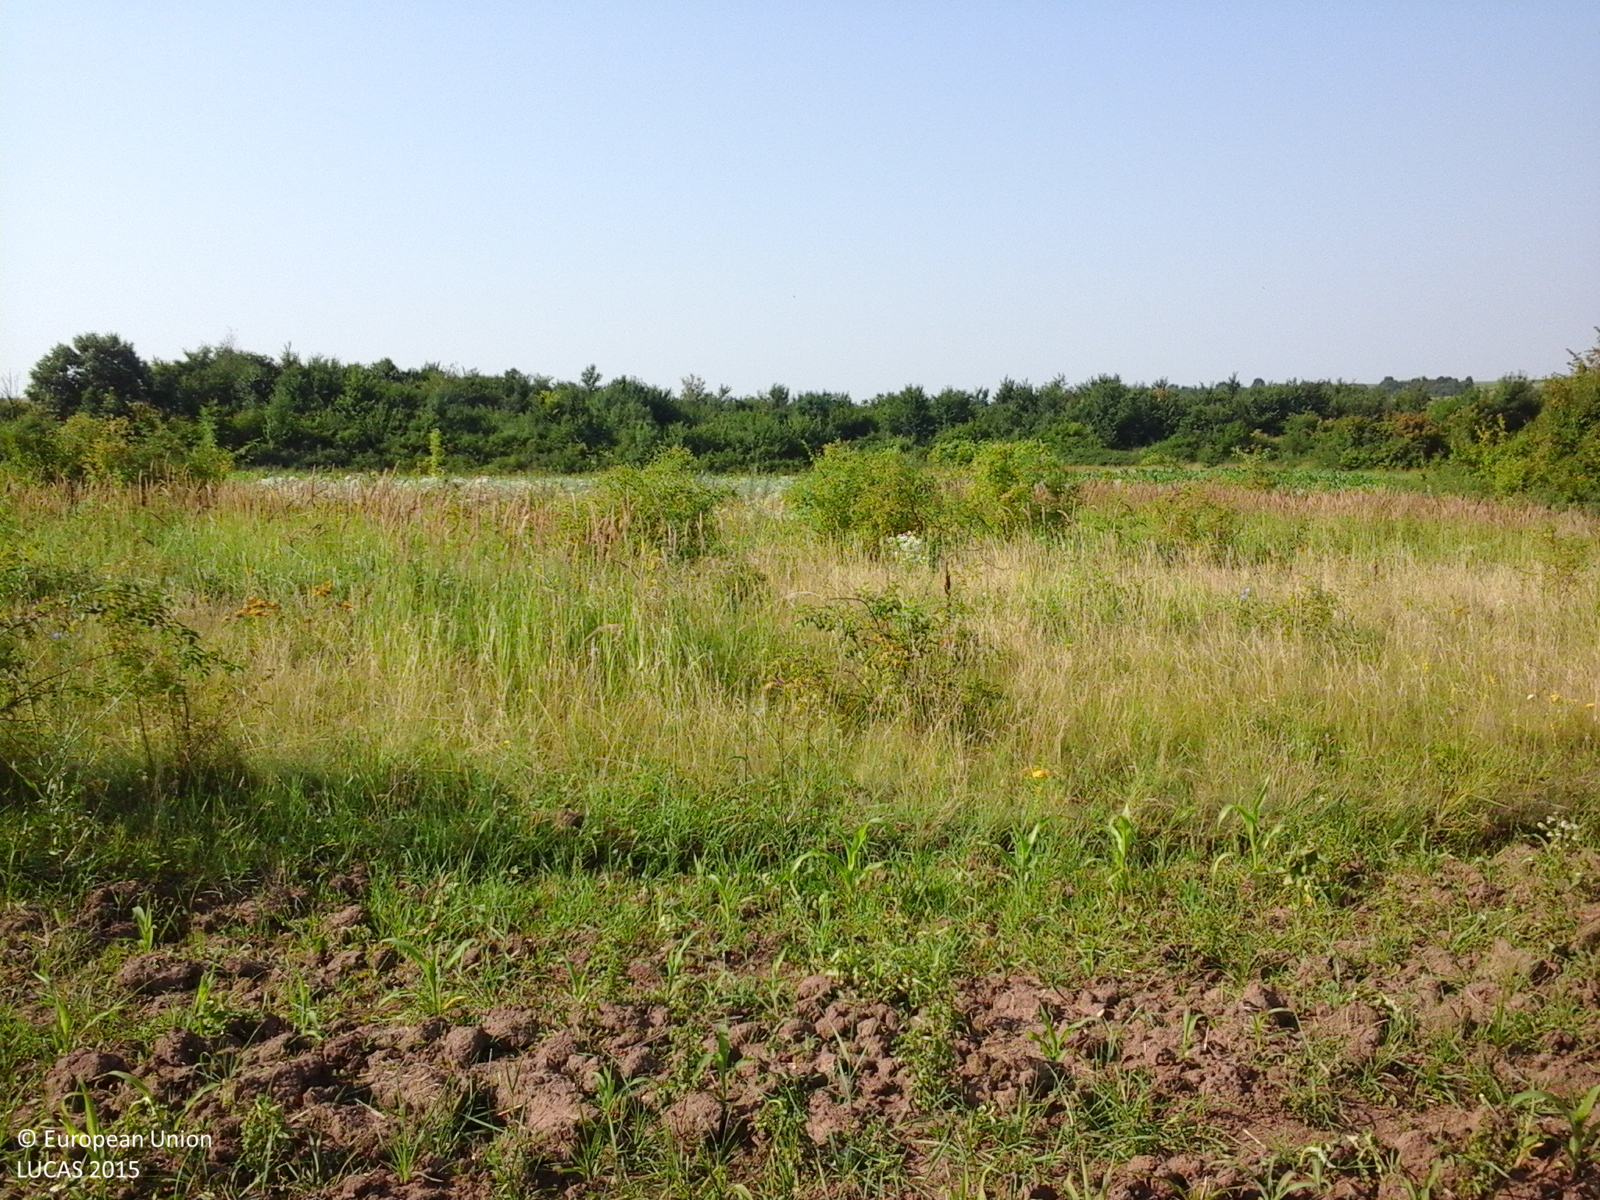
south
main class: Cropland
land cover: Maize
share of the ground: < 10 %
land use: Agriculture (excluding fallow land and kitchen gardens)
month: July
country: RO
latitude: 44.6105
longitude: 24.6028
